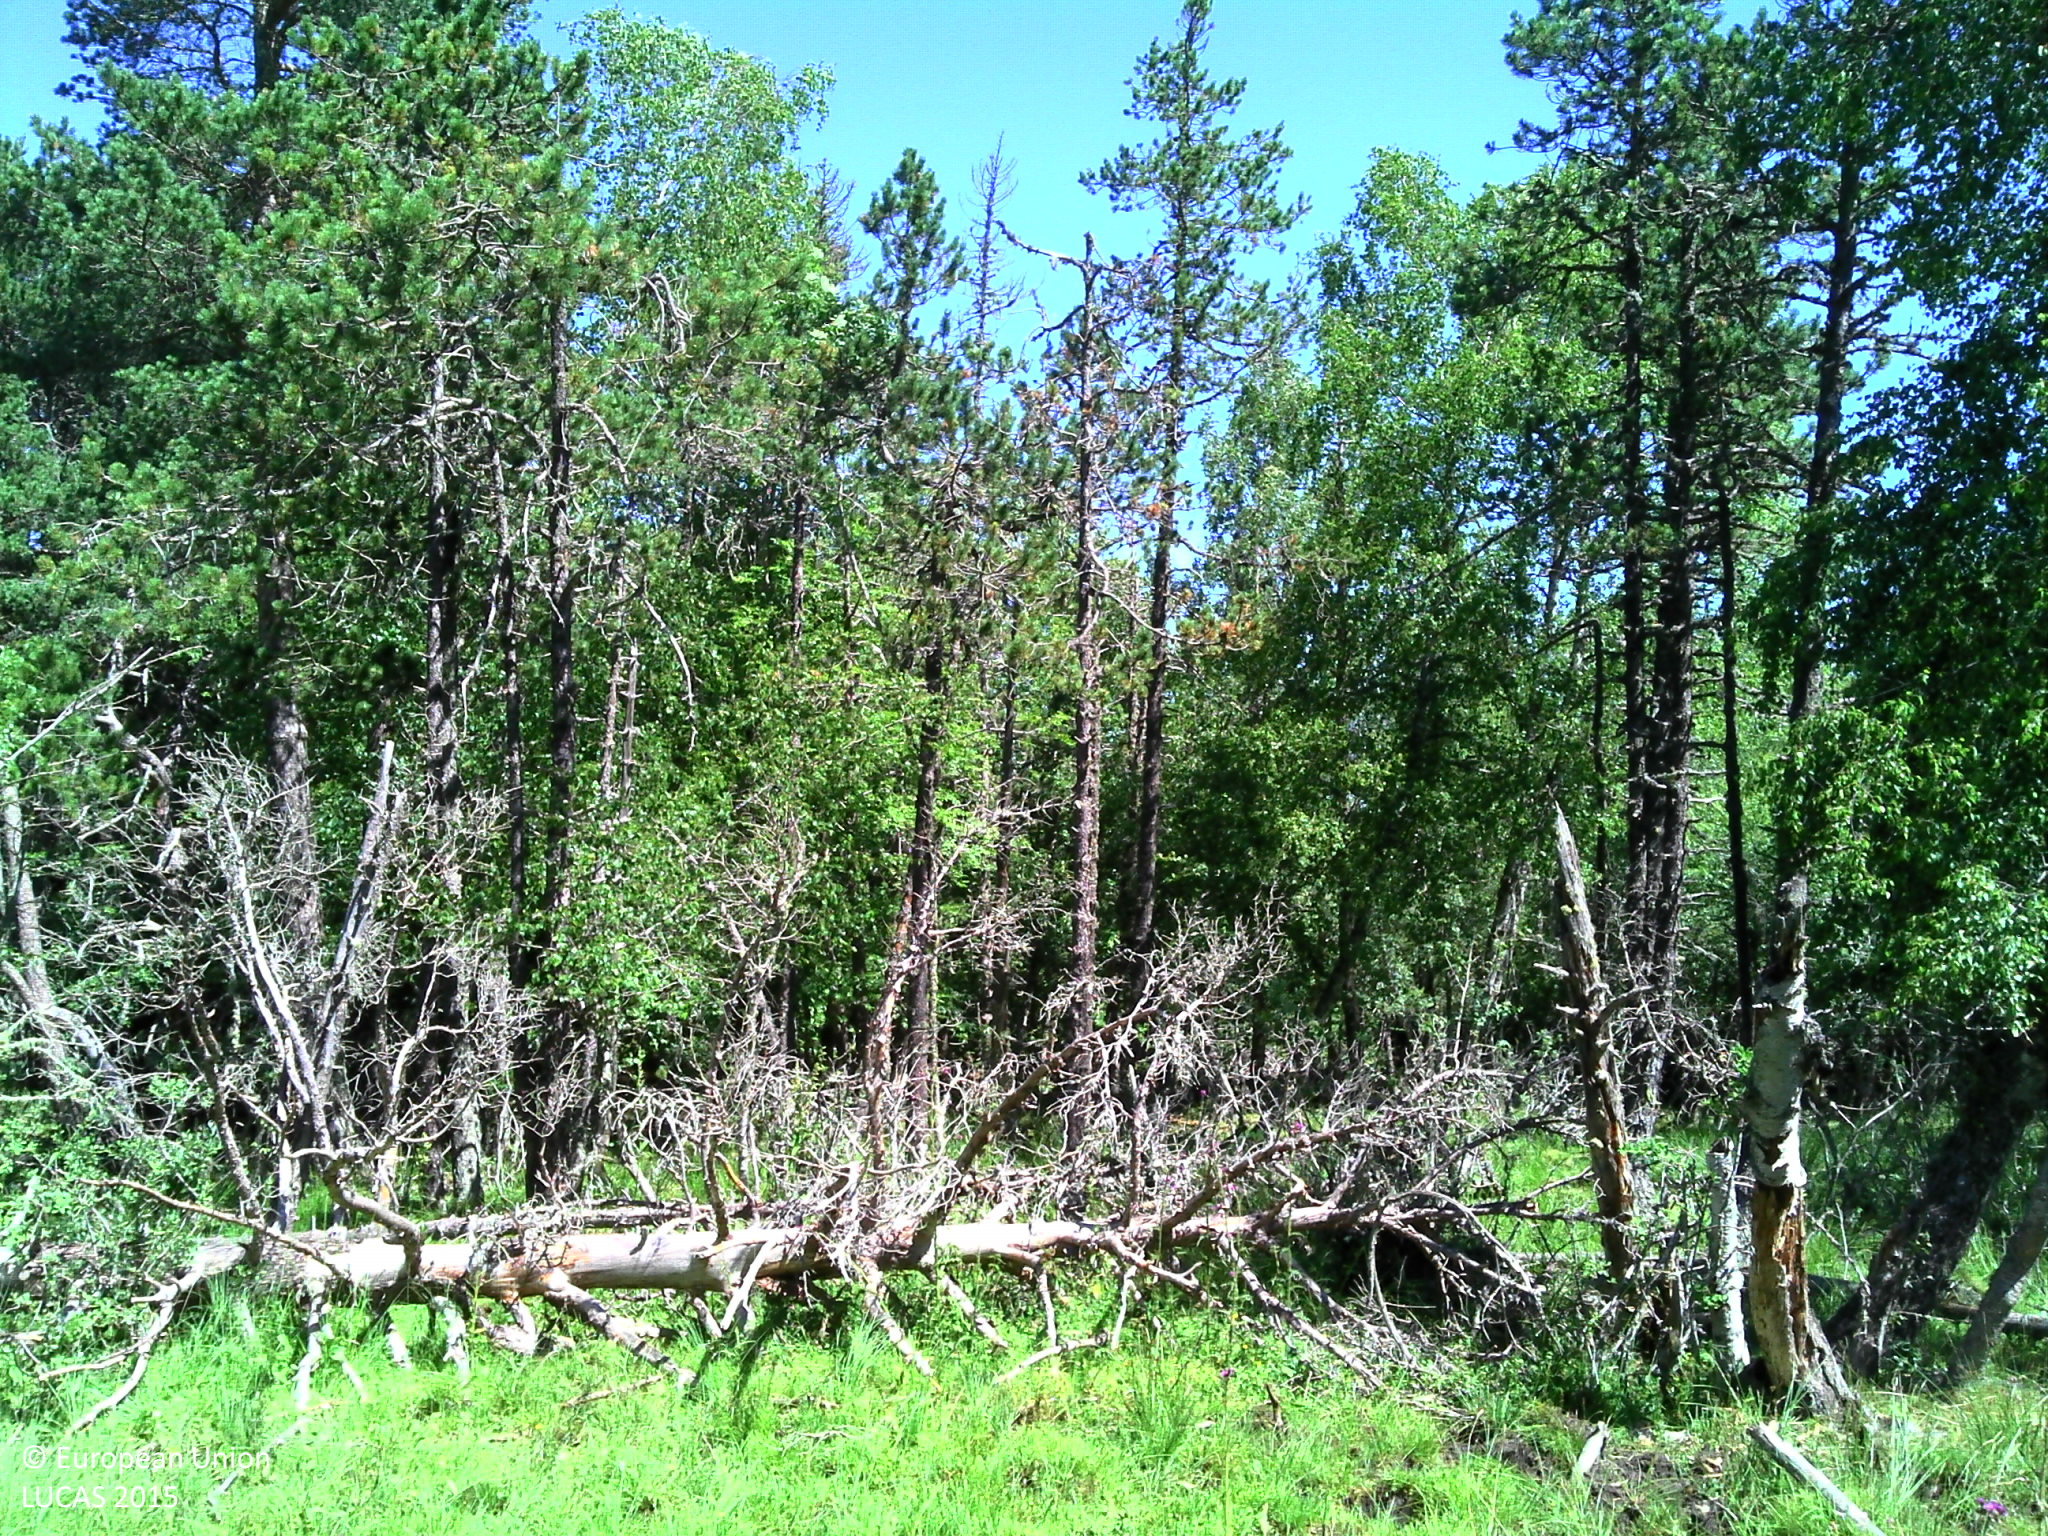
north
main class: Woodland
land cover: Pine dominated mixed woodland
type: hemiboreal forest and nemoral coniferous forest and mixed broadleaved-coniferous forest
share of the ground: > 75 %
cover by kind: broadleaved forest trees 40 %, coniferous forest trees 35 %, herbaceous plants 20 %
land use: Forestry
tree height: > 5 m
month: July
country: FR
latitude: 42.6728
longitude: 2.1155
